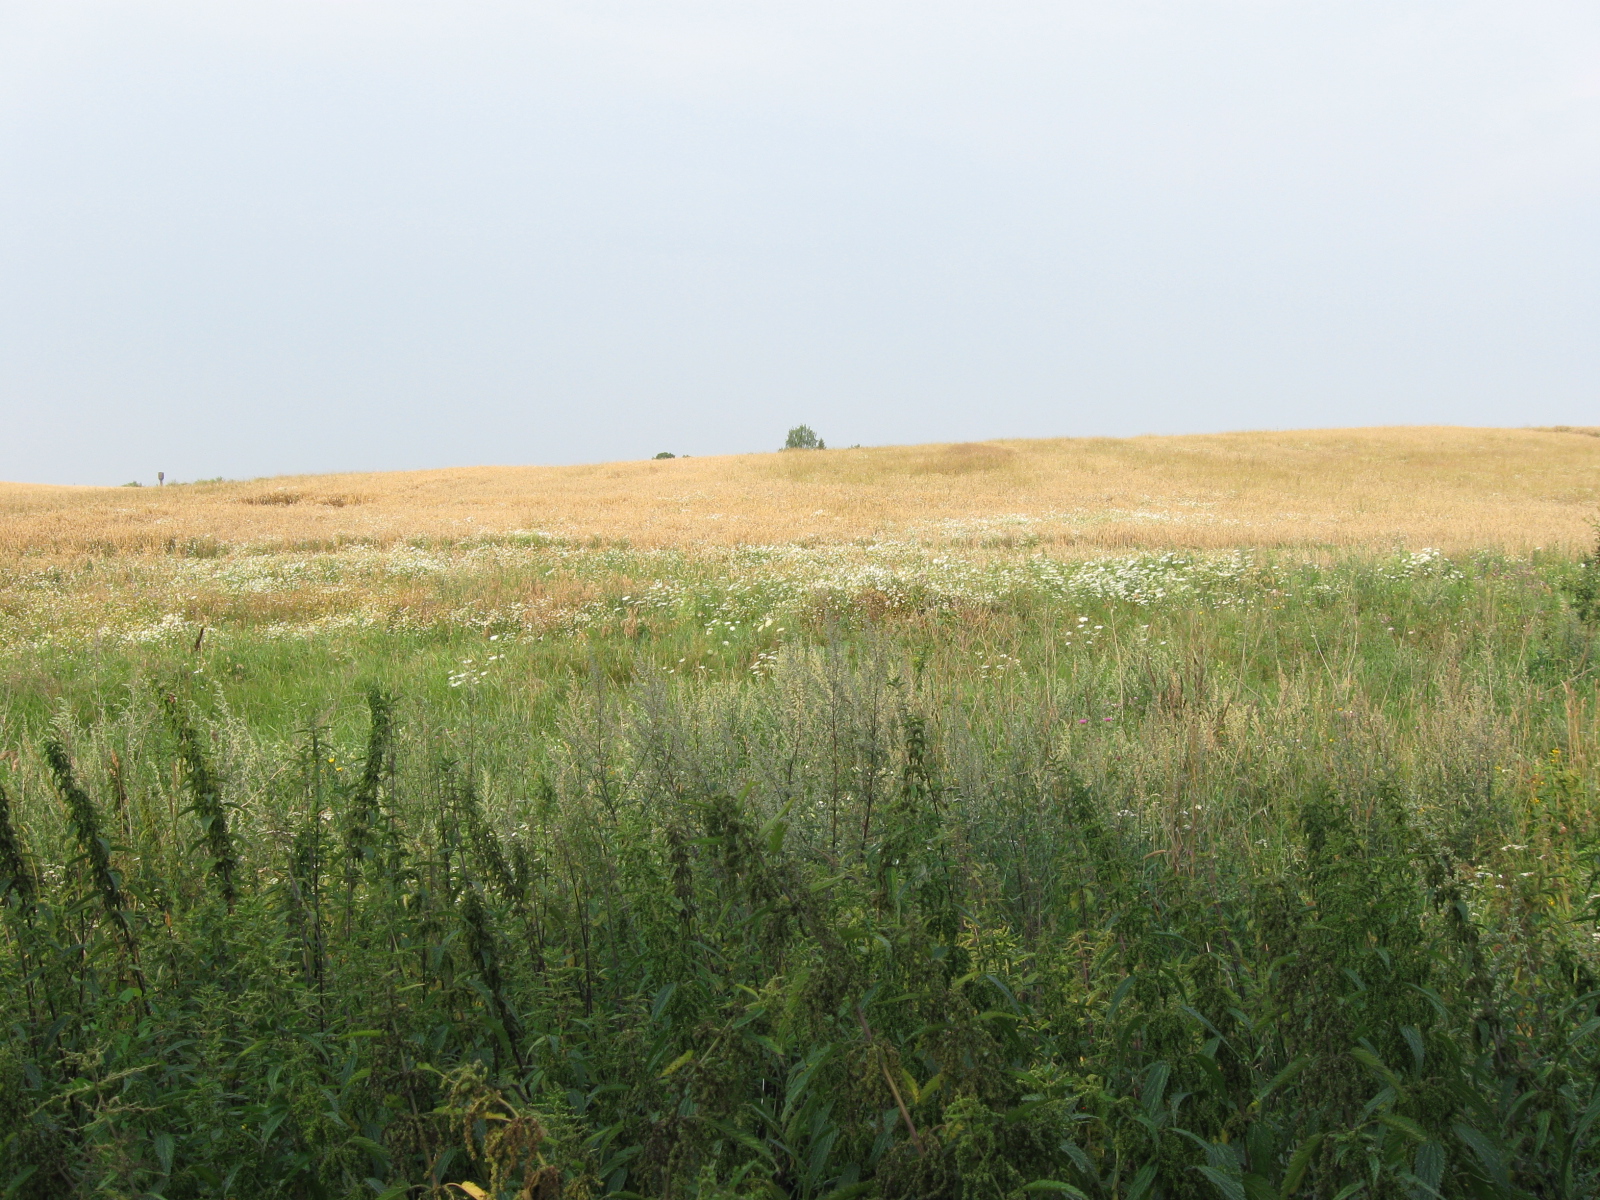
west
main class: Woodland
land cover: Broadleaved woodland
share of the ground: 50 - 75 %
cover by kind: broadleaved forest trees 60 %, shrubs 20 %, herbaceous plants 20 %
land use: Semi-natural and natural areas not in use
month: August
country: LT
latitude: 54.5442
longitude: 23.4521
